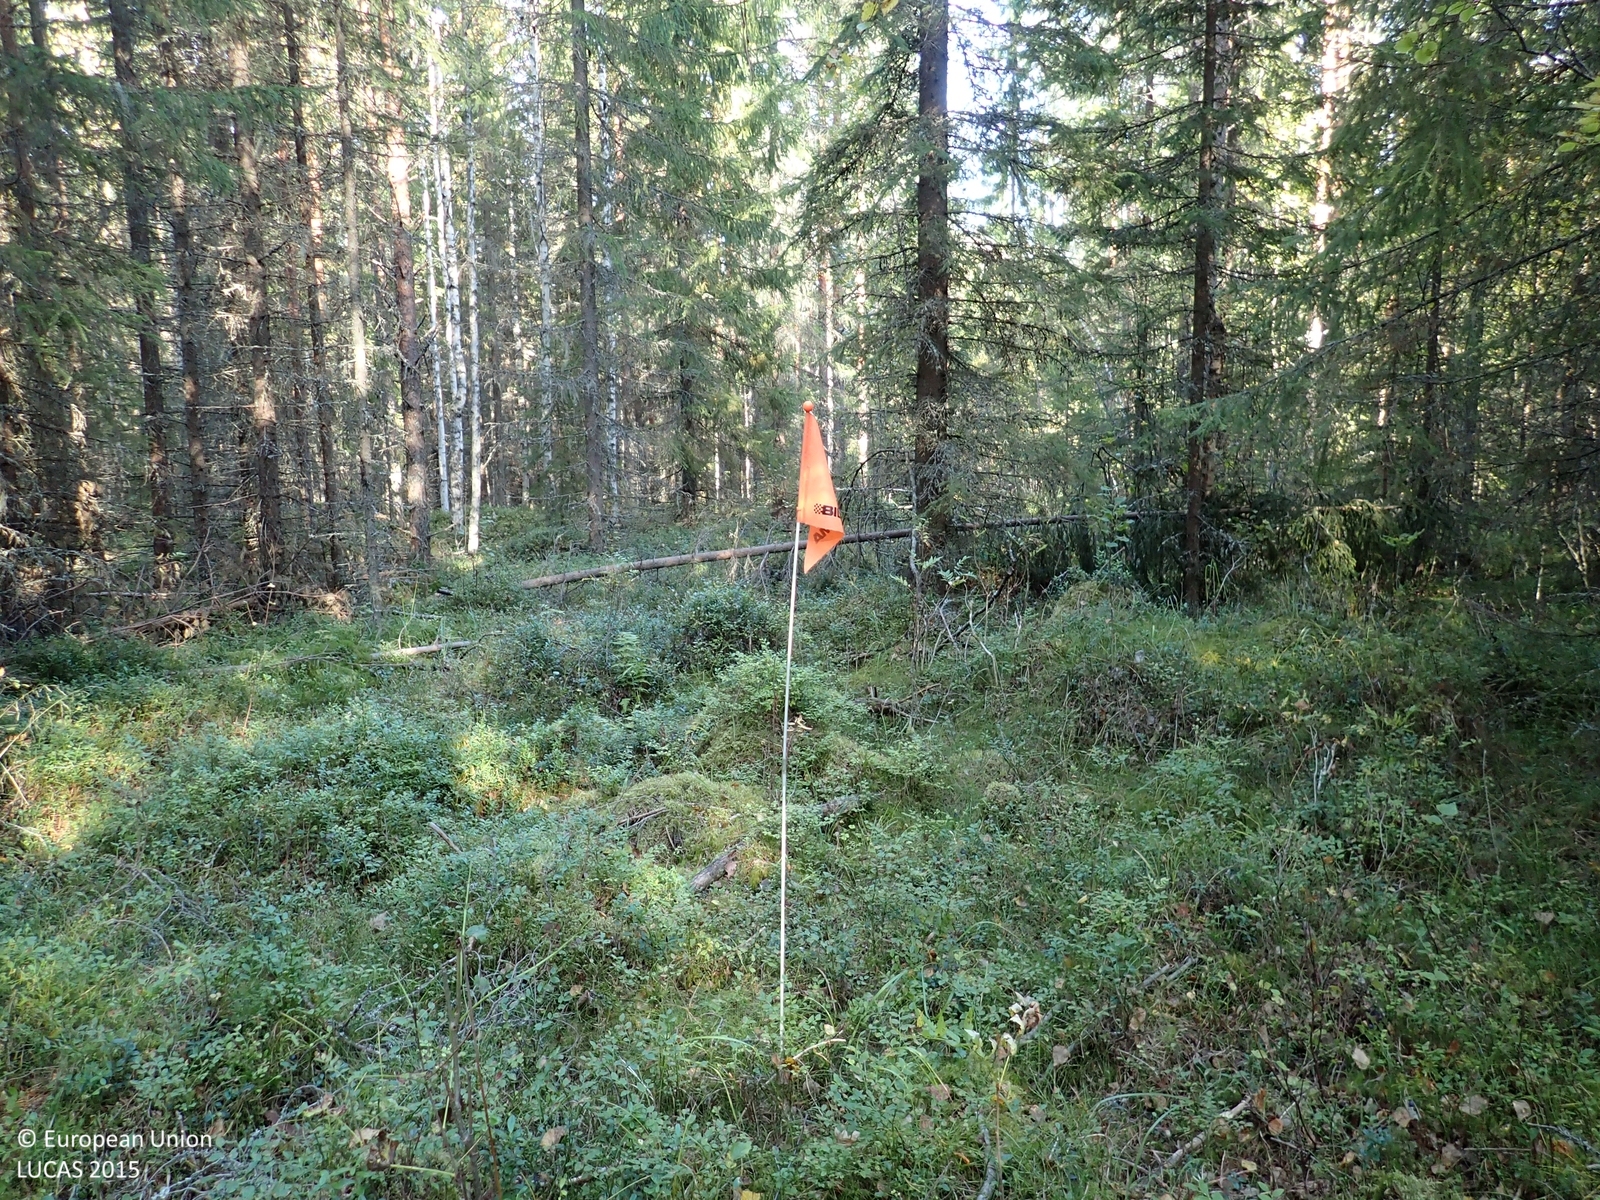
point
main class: Woodland
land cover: Spruce dominated coniferous woodland
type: boreal forest
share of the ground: > 75 %
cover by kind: coniferous forest trees 70 %, shrubs 15 %, broadleaved forest trees 10 %, lichens and mosses 5 %
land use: Forestry
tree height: > 5 m
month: September
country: FI
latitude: 62.9075
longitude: 25.5187
